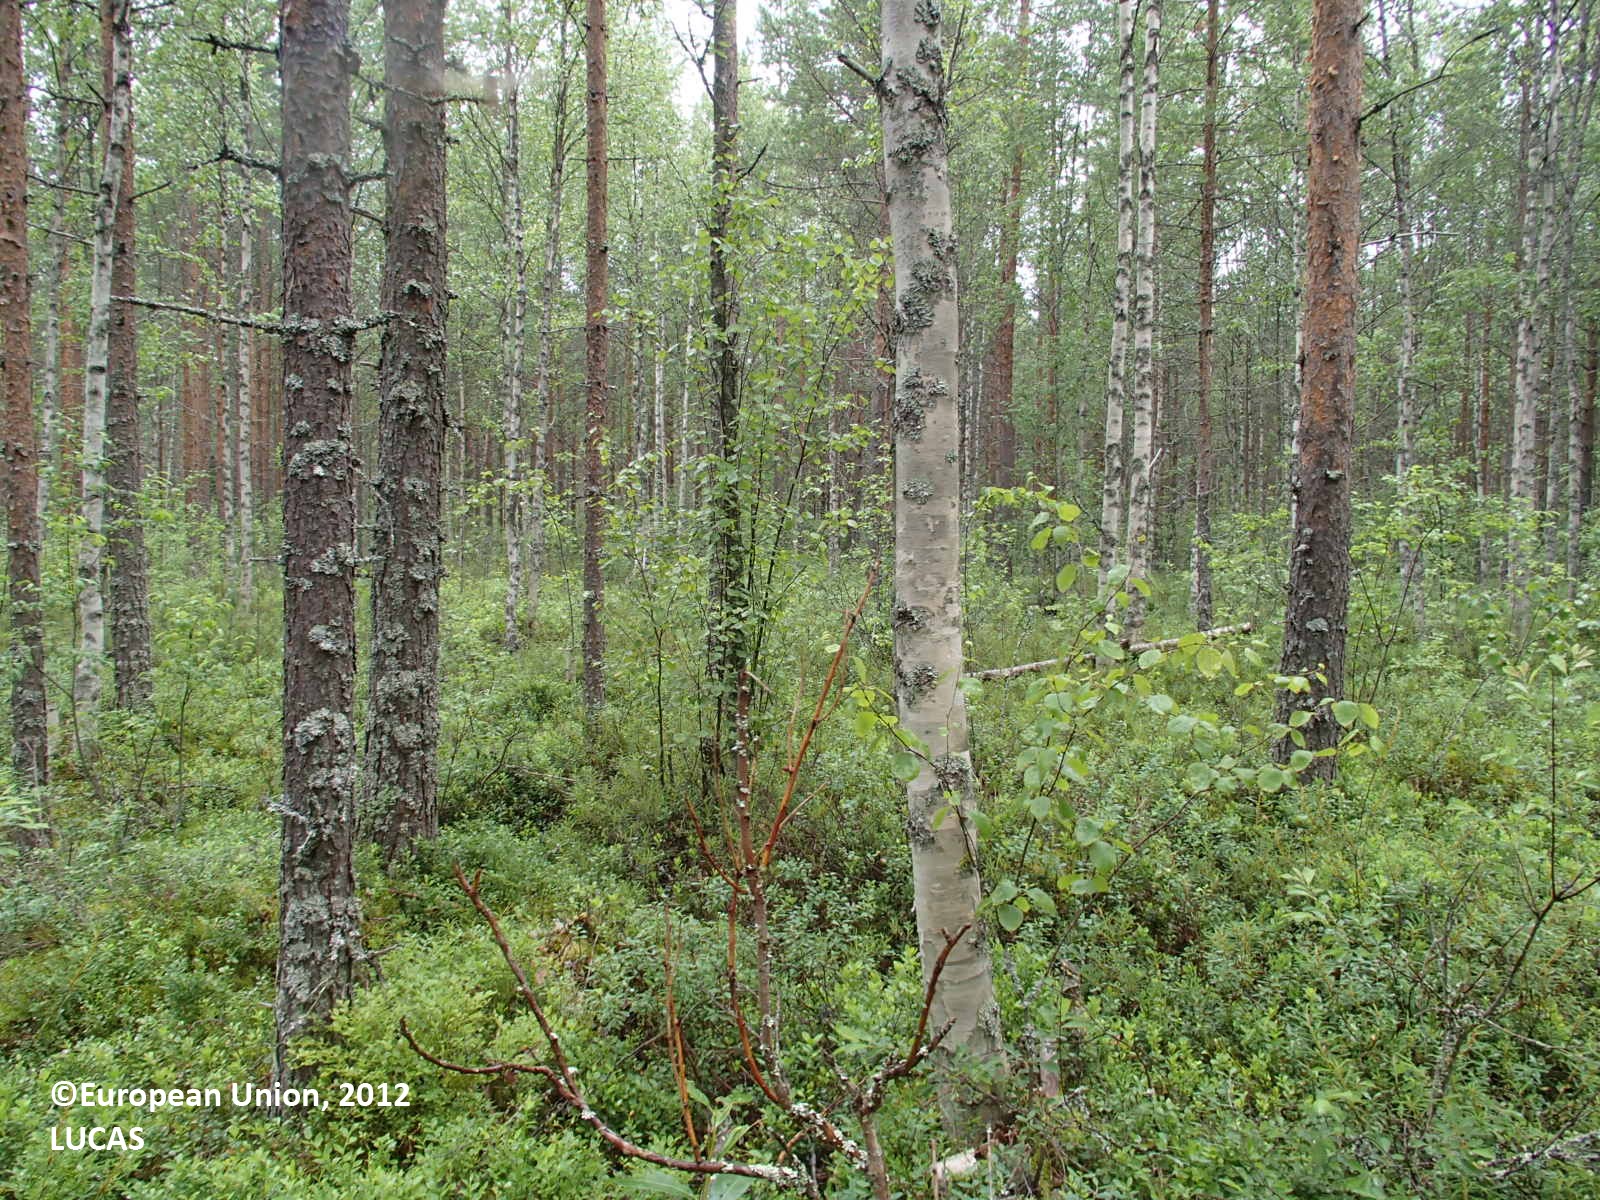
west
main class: Woodland
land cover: Pine dominated mixed woodland
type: boreal forest
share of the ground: > 75 %
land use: Forestry
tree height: > 5 m
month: July
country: FI
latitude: 64.1668
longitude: 26.2164
